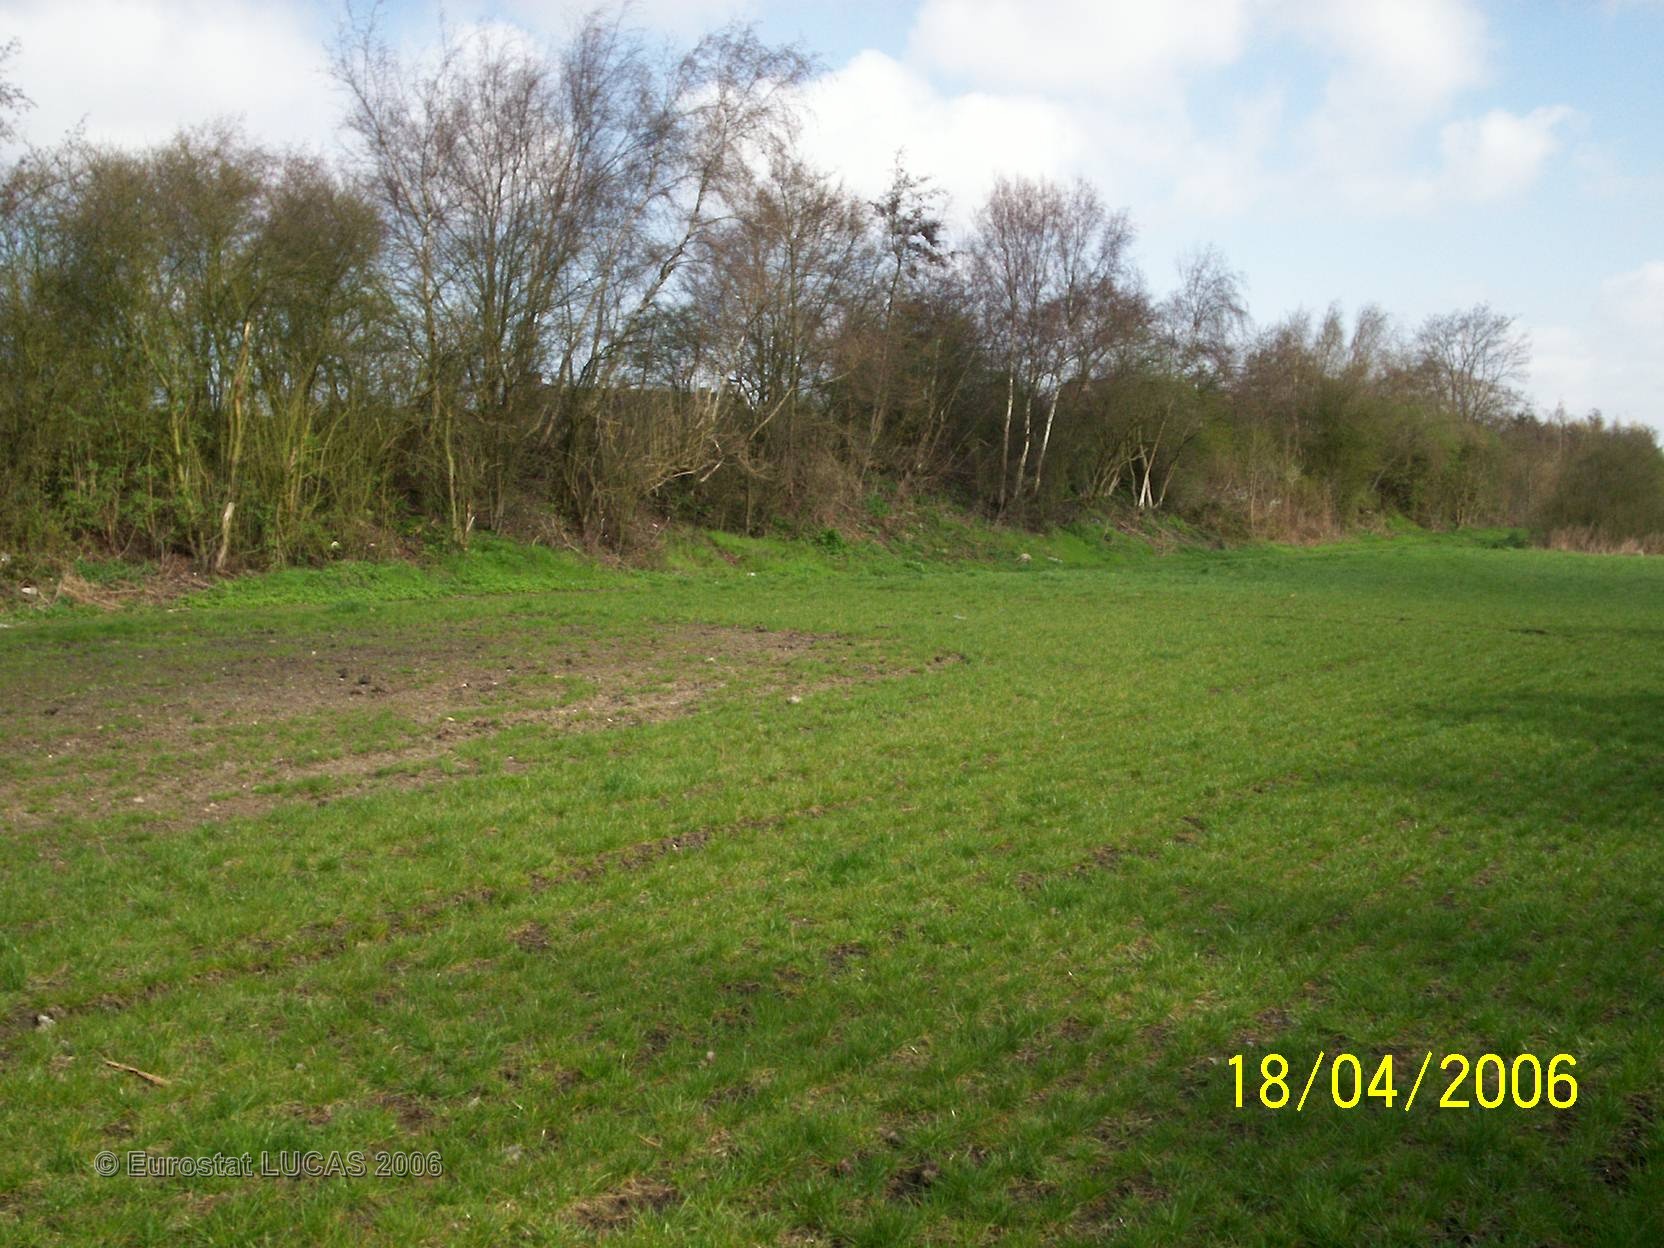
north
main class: Grassland
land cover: Grassland without tree/shrub cover
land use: Agriculture (excluding fallow land and kitchen gardens)
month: April
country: FR
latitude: 50.4507
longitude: 2.6223
